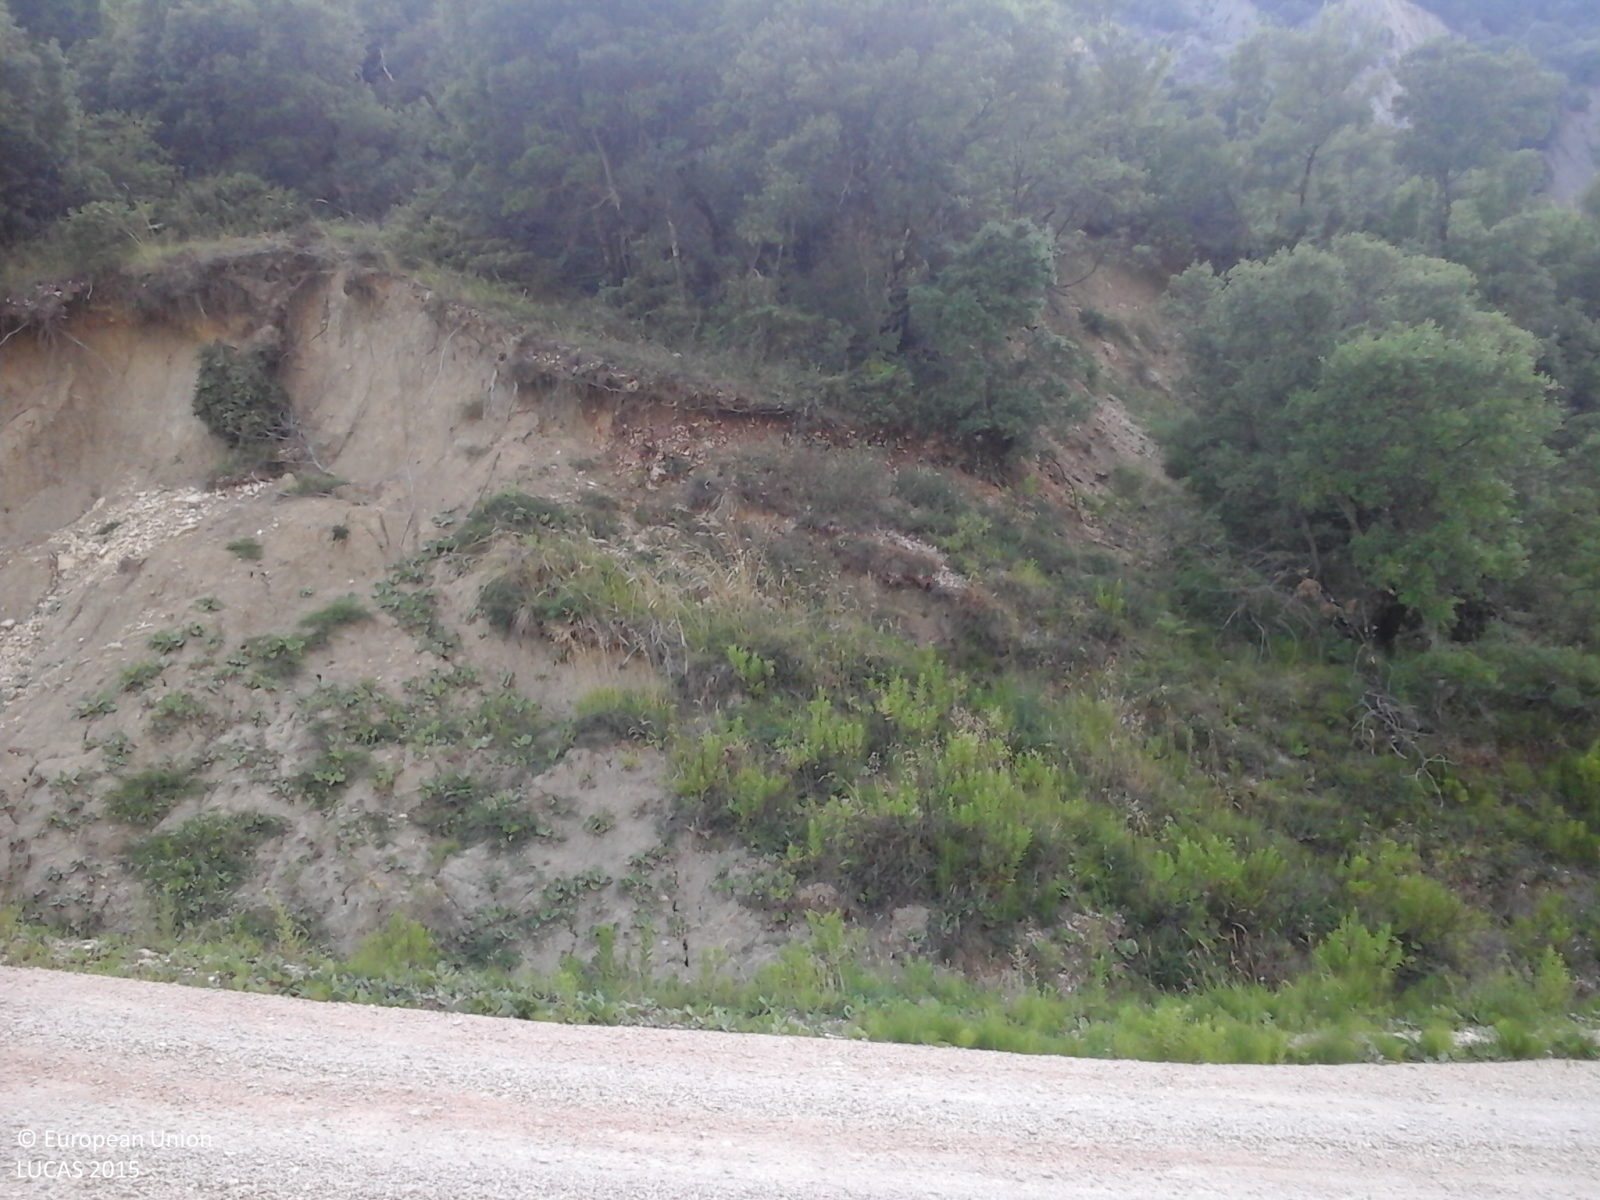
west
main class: Woodland
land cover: Broadleaved woodland
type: broadleaved evergreen forest
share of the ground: 50 - 75 %
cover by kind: broadleaved forest trees 70 %, unconsolidated bare surface 20 %, shrubs 10 %
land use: Semi-natural and natural areas not in use
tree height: > 5 m
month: July
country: GR
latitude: 39.4740
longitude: 20.7519
